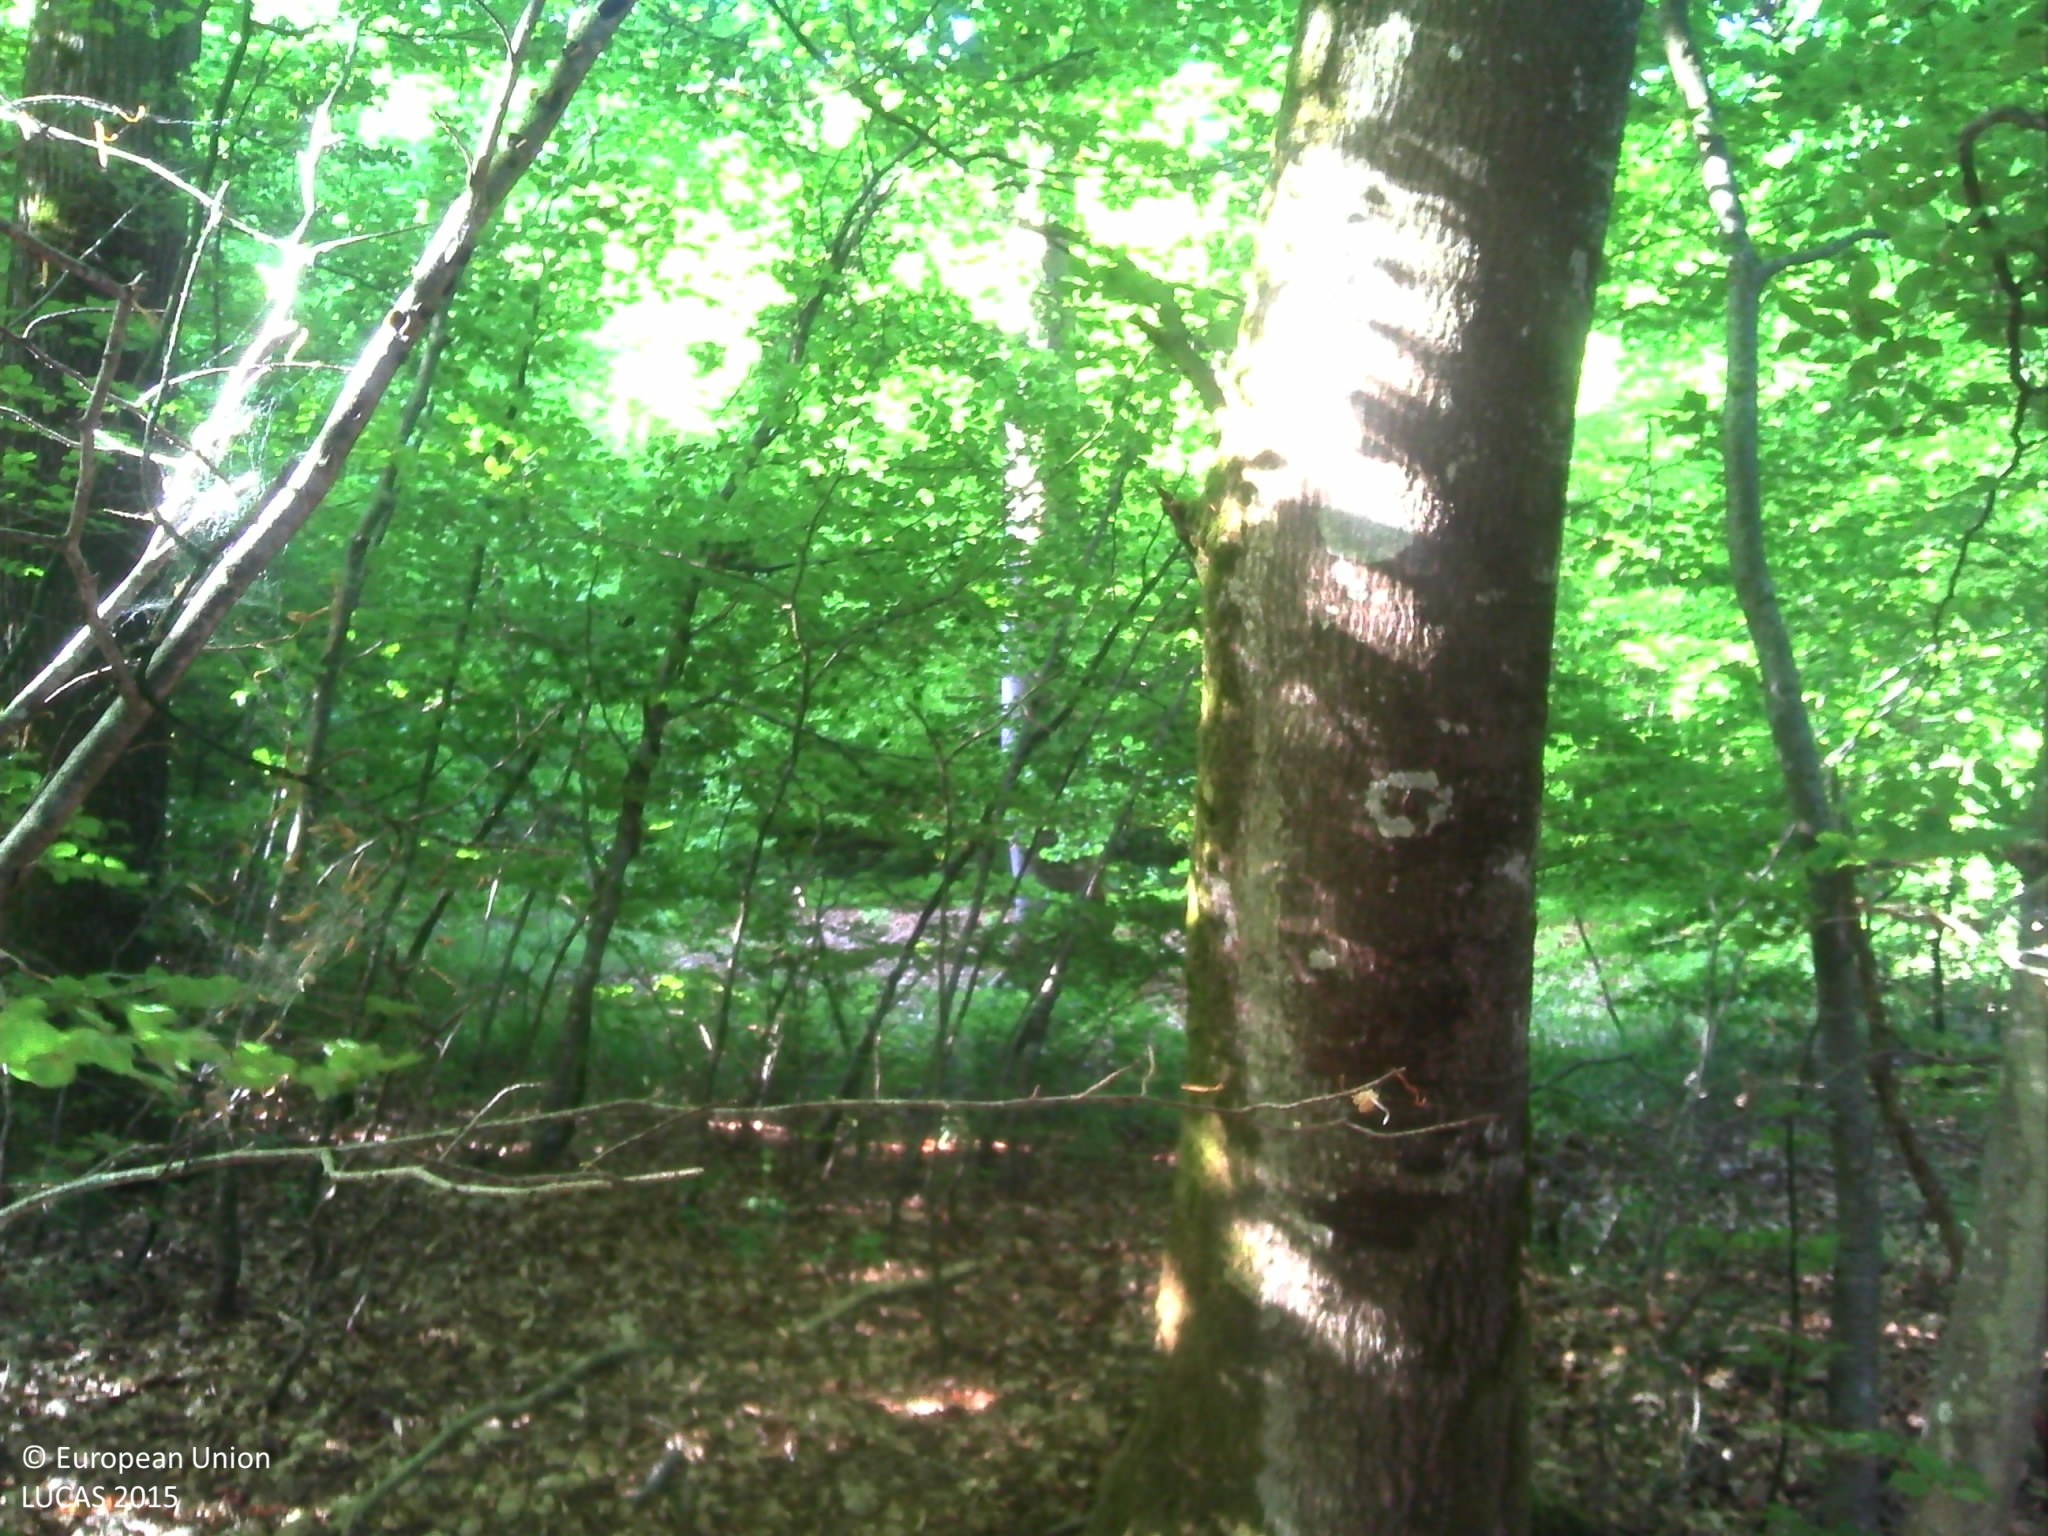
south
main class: Woodland
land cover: Broadleaved woodland
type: acidophilous oak and oak-birch forest
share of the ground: > 75 %
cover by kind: broadleaved forest trees 95 %, herbaceous plants 5 %
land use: Forestry
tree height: > 5 m
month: May
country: LU
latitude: 49.8178
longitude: 6.2886
